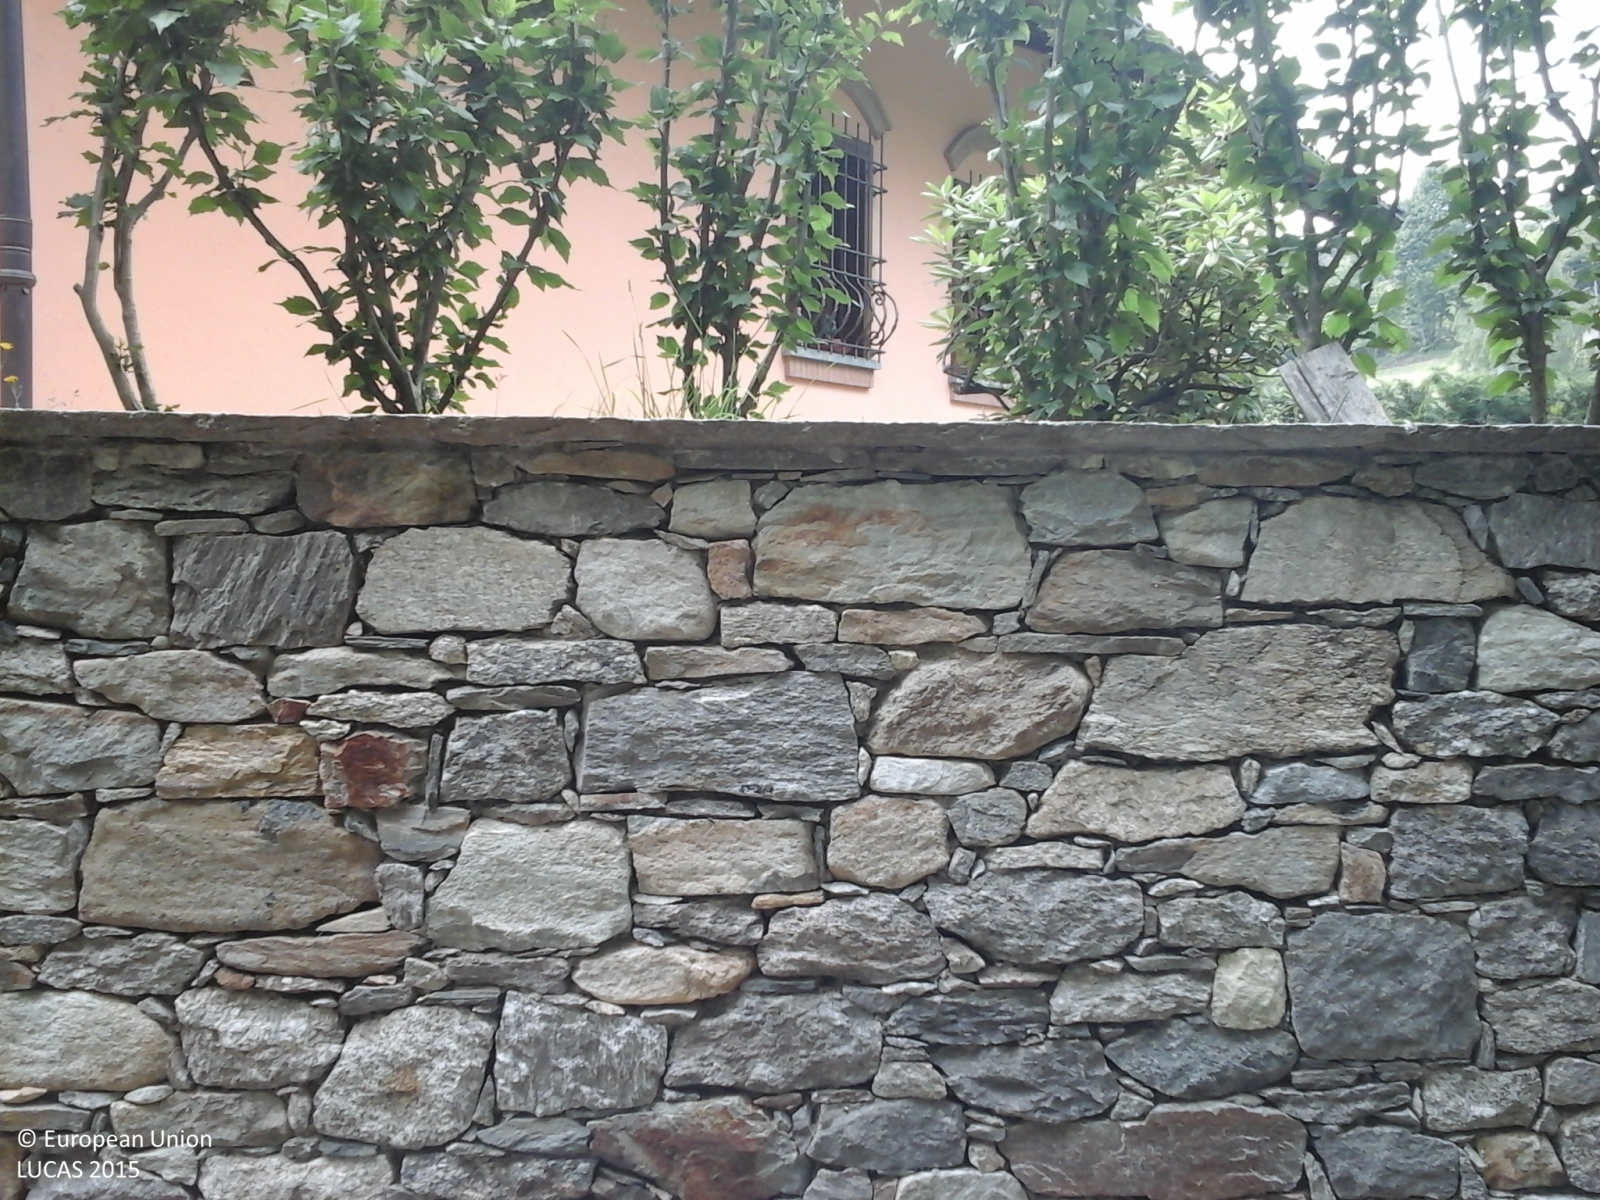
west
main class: Woodland
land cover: Broadleaved woodland
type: thermophilous deciduous forest
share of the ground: > 75 %
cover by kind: broadleaved forest trees 100 %
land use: Semi-natural and natural areas not in use
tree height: > 5 m
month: May
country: IT
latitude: 45.3896
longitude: 7.7173
